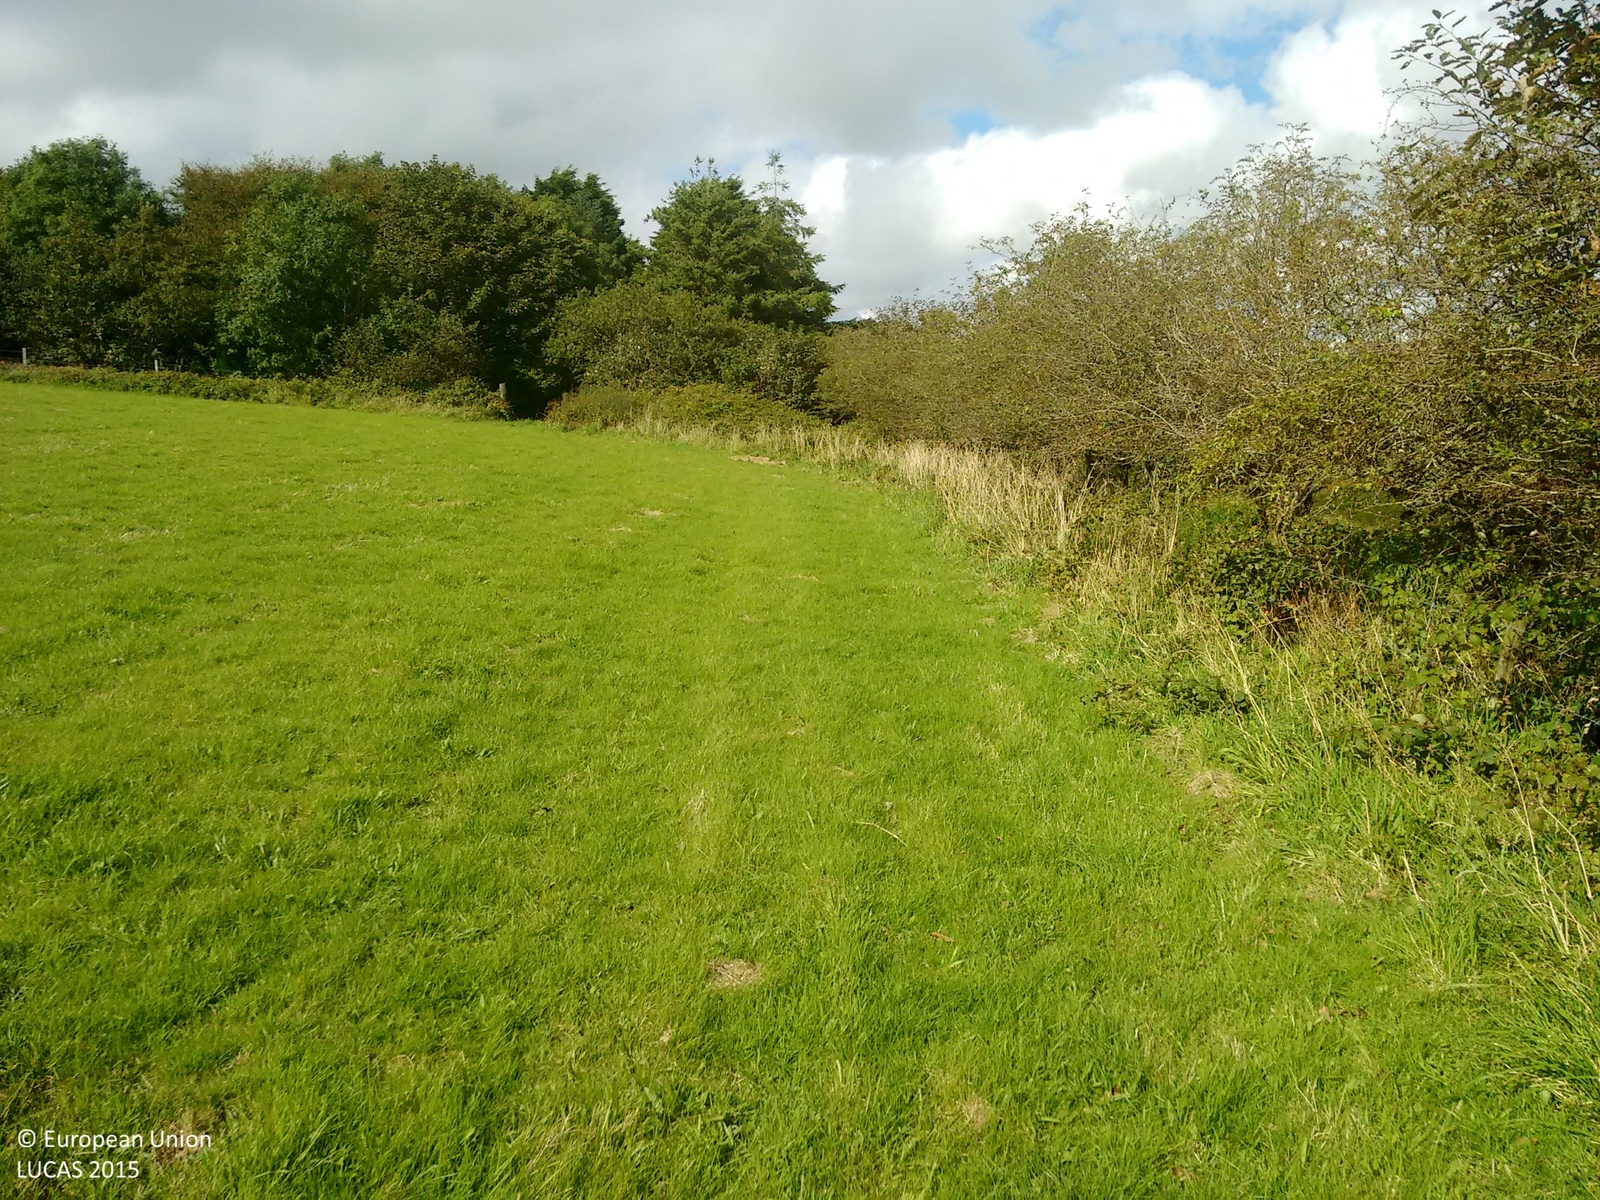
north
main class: Grassland
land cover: Grassland without tree/shrub cover
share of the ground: > 75 %
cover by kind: herbaceous plants 100 %
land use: Agriculture (excluding fallow land and kitchen gardens)
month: September
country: GB
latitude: 50.1569
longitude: -5.2520
